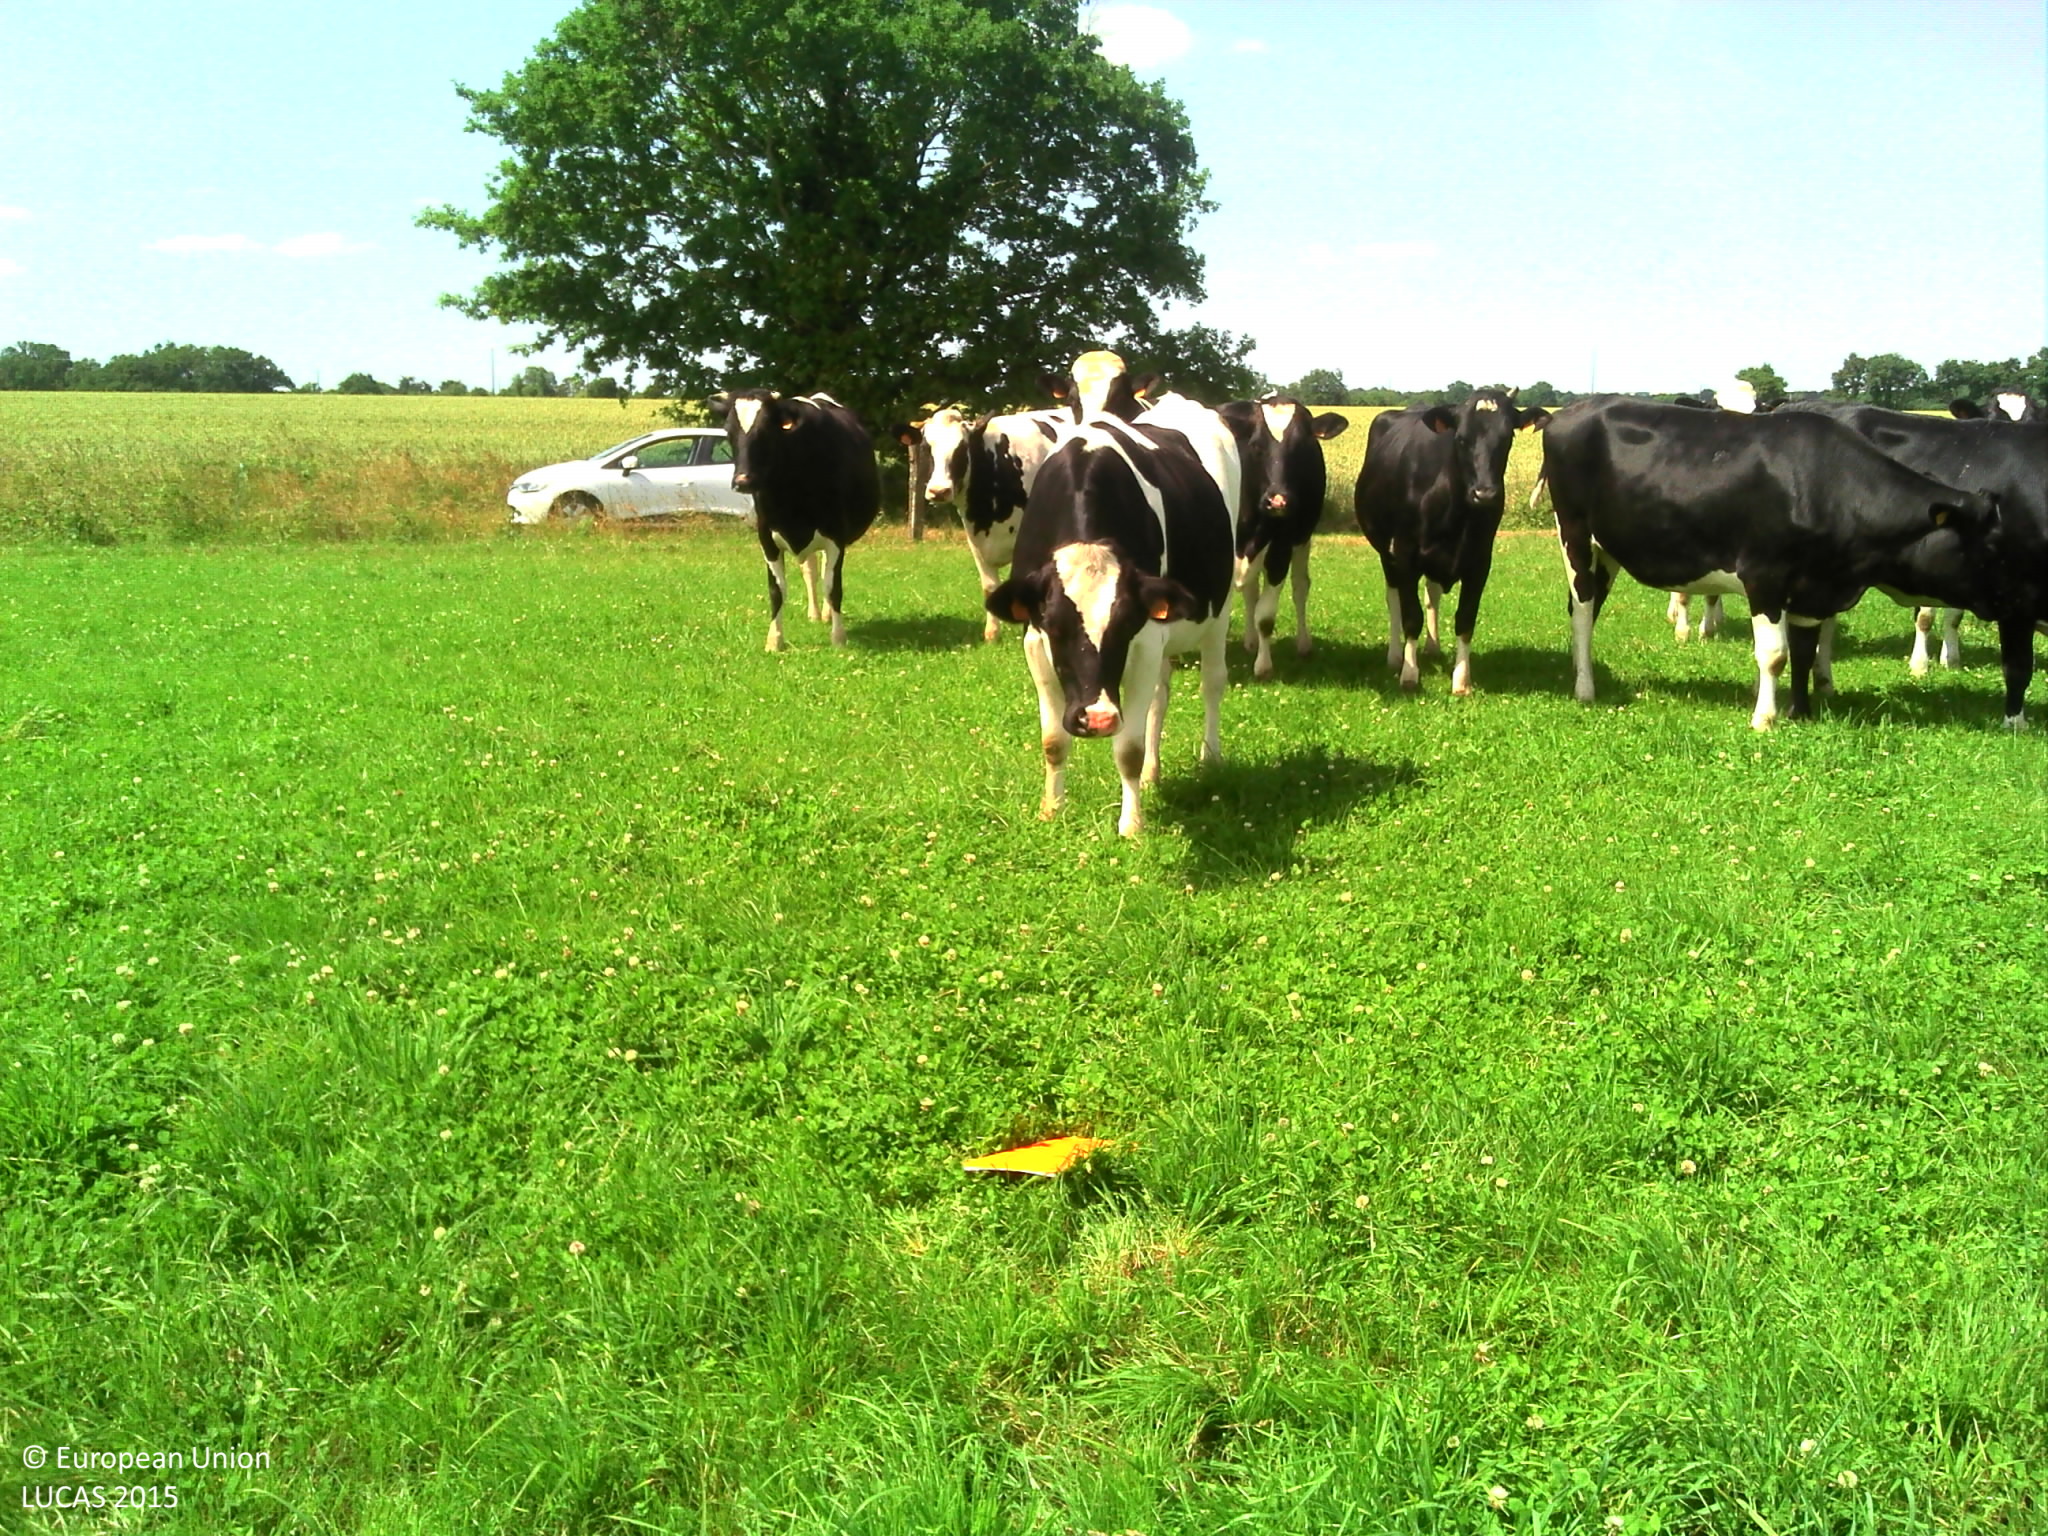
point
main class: Cropland
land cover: Temporary grasslands
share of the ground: > 75 %
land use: Agriculture (excluding fallow land and kitchen gardens)
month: June
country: FR
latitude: 46.8627
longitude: -1.4381
